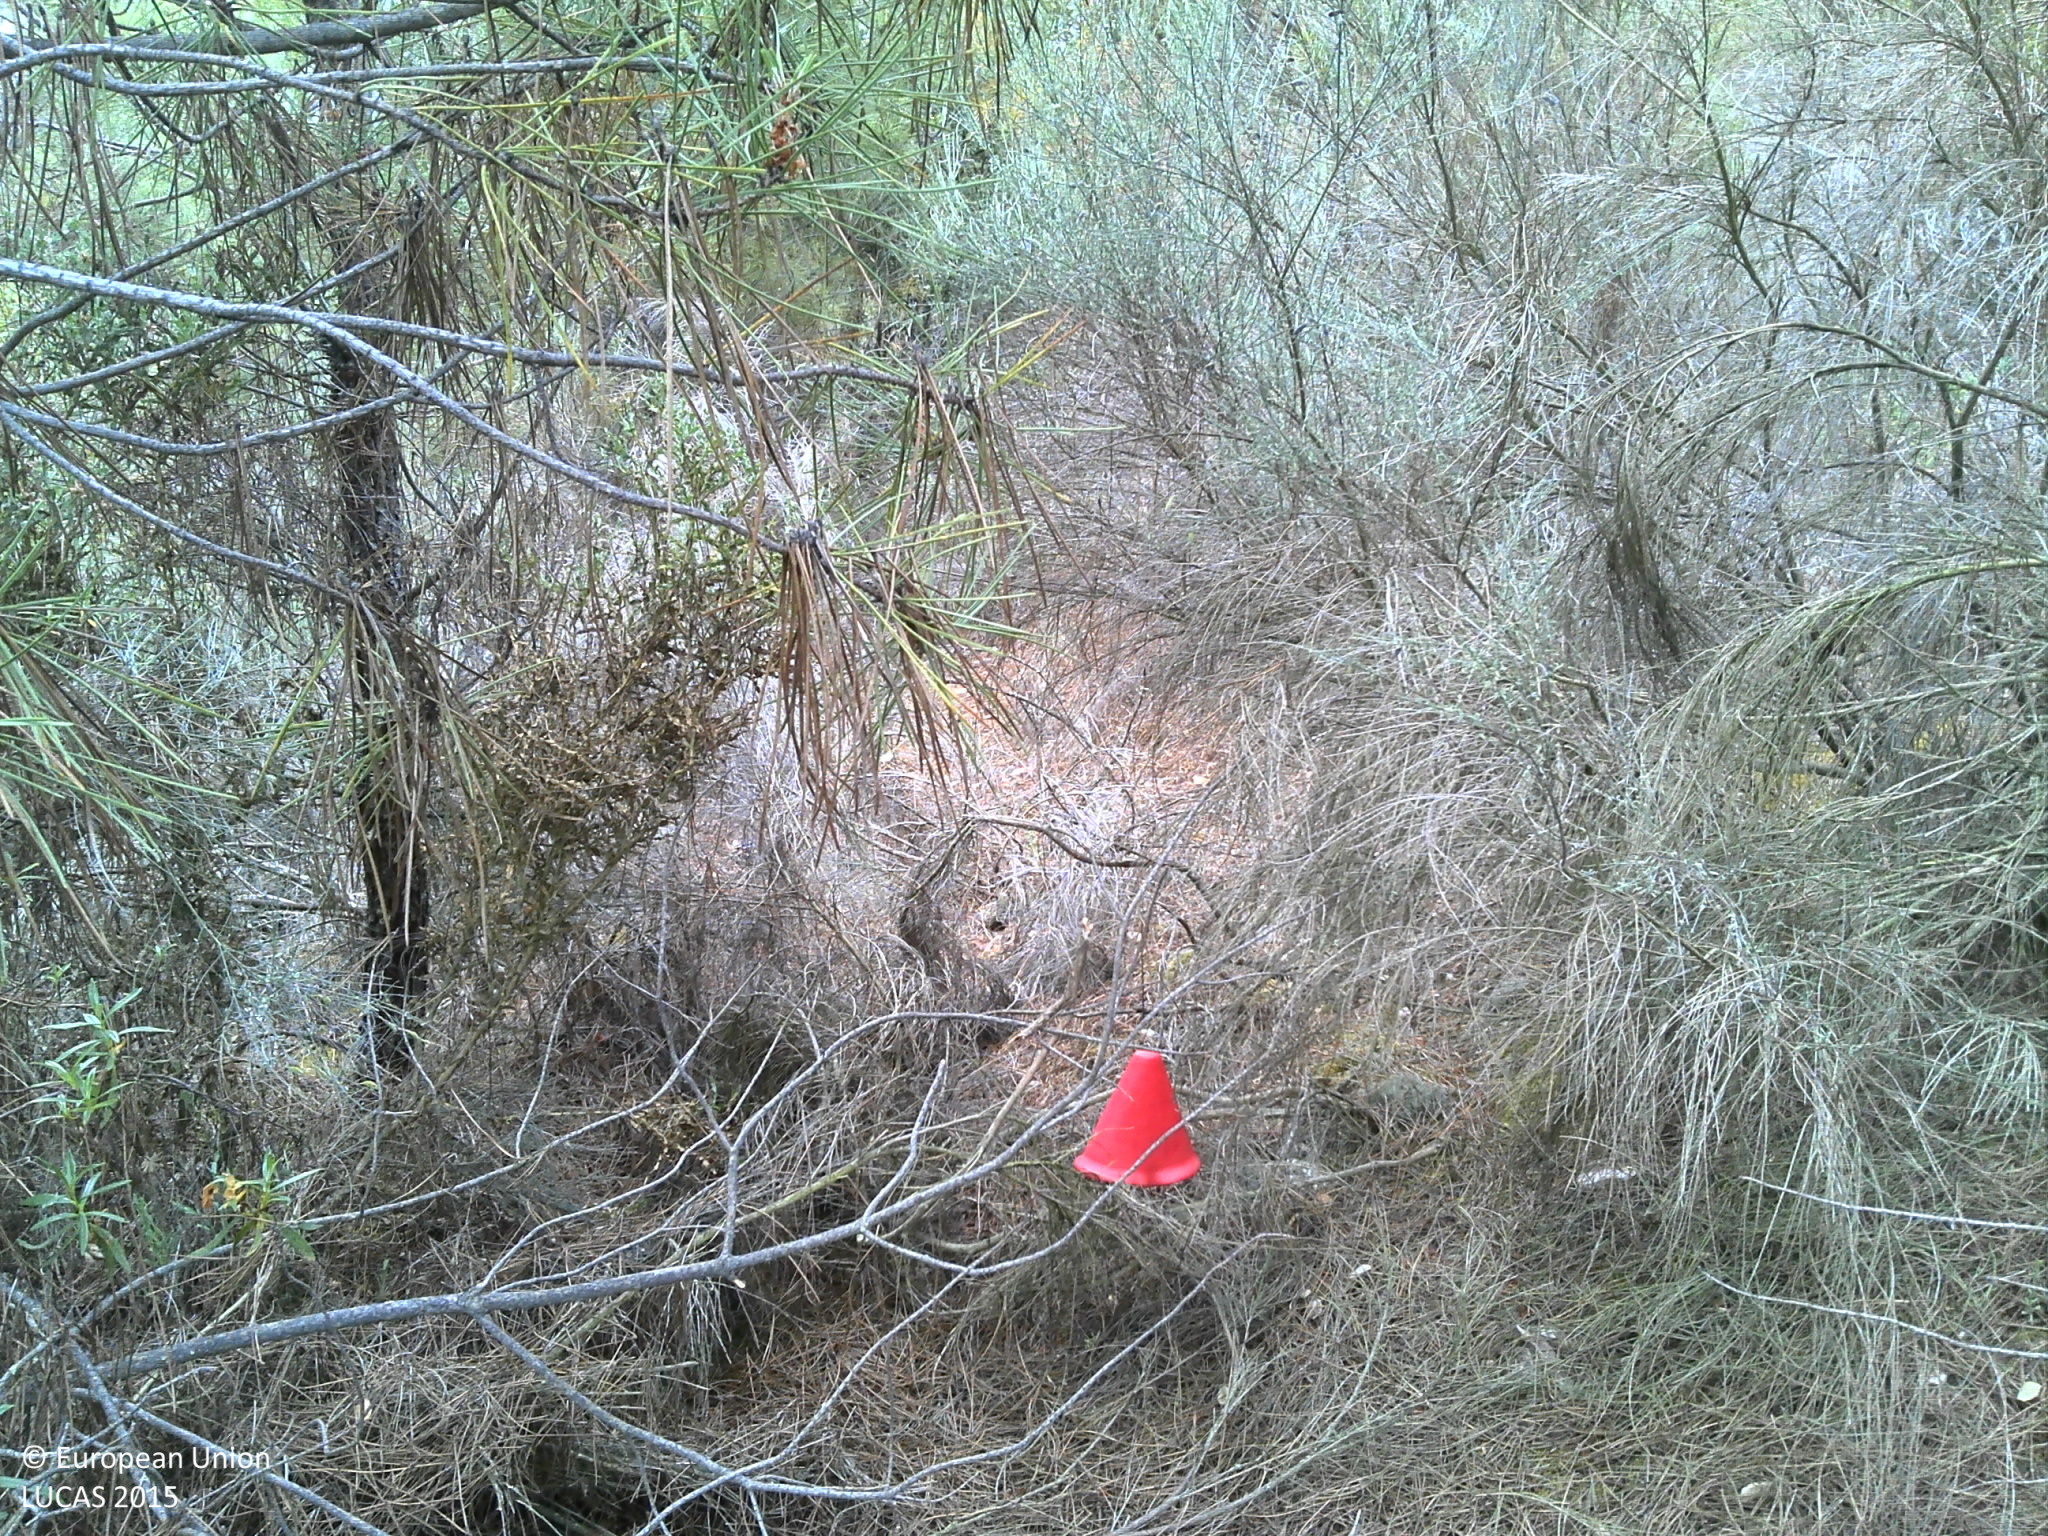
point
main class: Woodland
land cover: Pine dominated coniferous woodland
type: coniferous forest of the mediterranean region
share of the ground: 25 - 50 %
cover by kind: shrubs 55 %, coniferous forest trees 25 %, unconsolidated bare surface 20 %
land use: Forestry
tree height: > 5 m
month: June
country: PT
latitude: 41.2638
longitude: -6.9762
